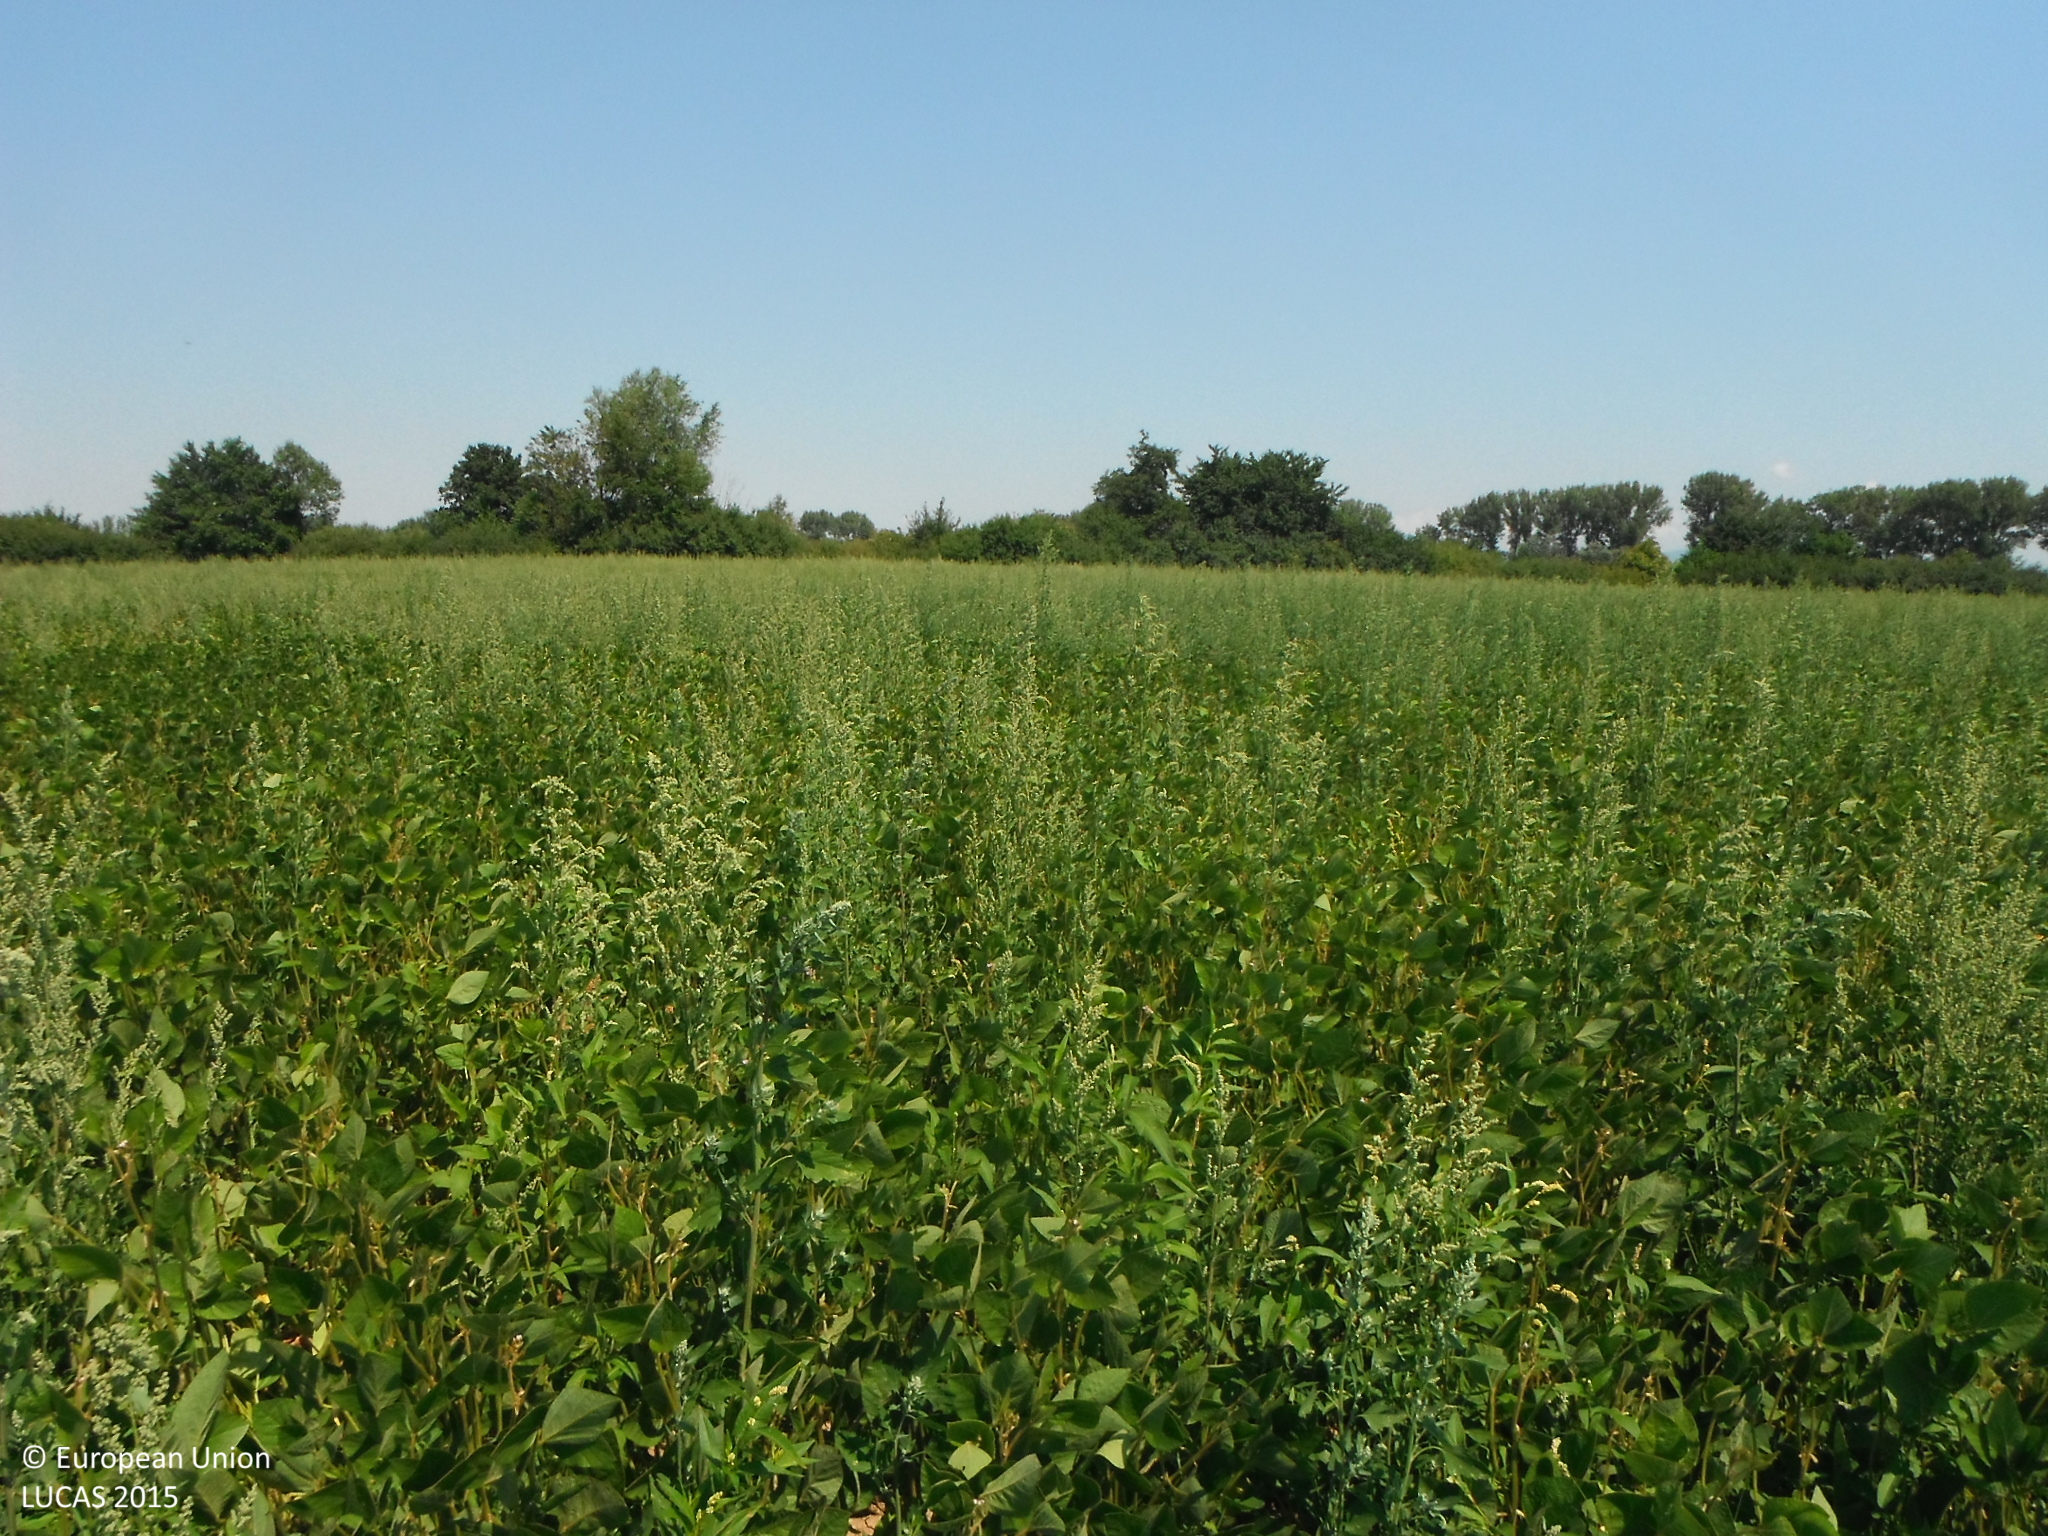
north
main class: Cropland
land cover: Soya
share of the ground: > 75 %
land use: Agriculture (excluding fallow land and kitchen gardens)
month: August
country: SK
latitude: 48.6844
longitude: 21.9114
